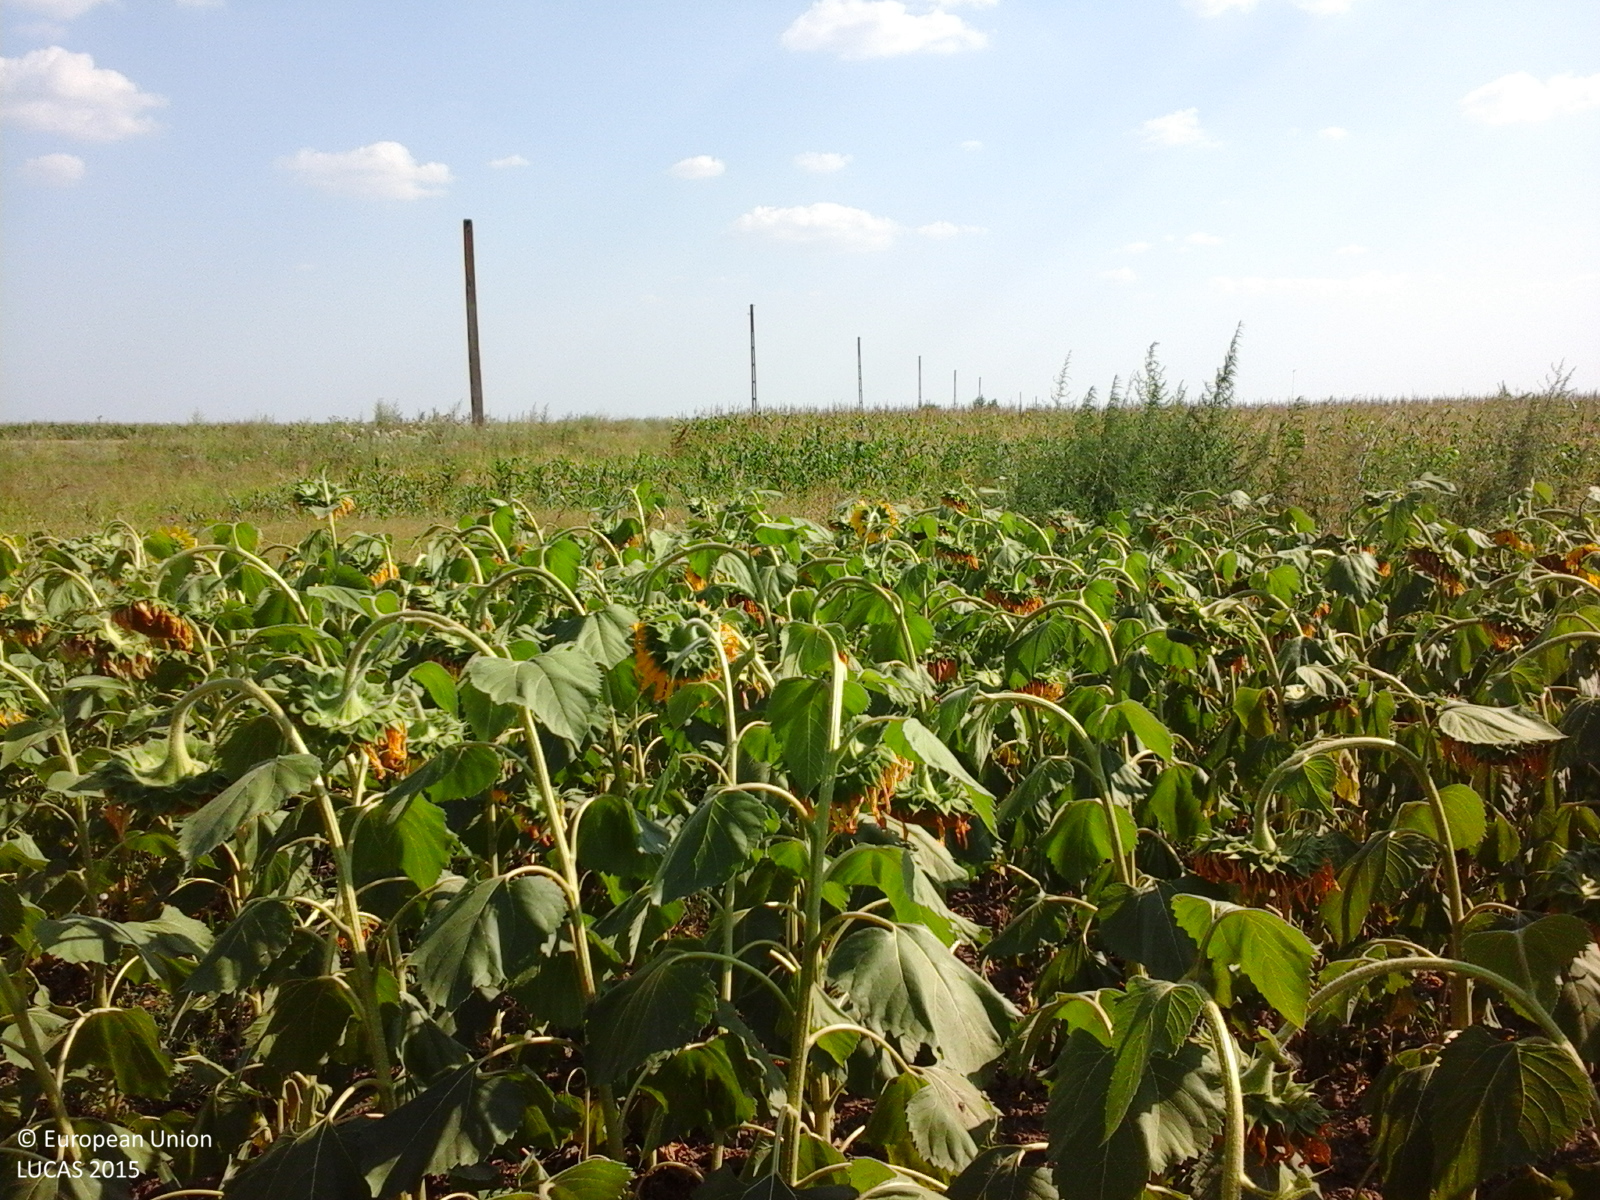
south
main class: Cropland
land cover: Sunflower
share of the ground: > 75 %
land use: Agriculture (excluding fallow land and kitchen gardens)
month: July
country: RO
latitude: 44.8645
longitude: 27.2377
